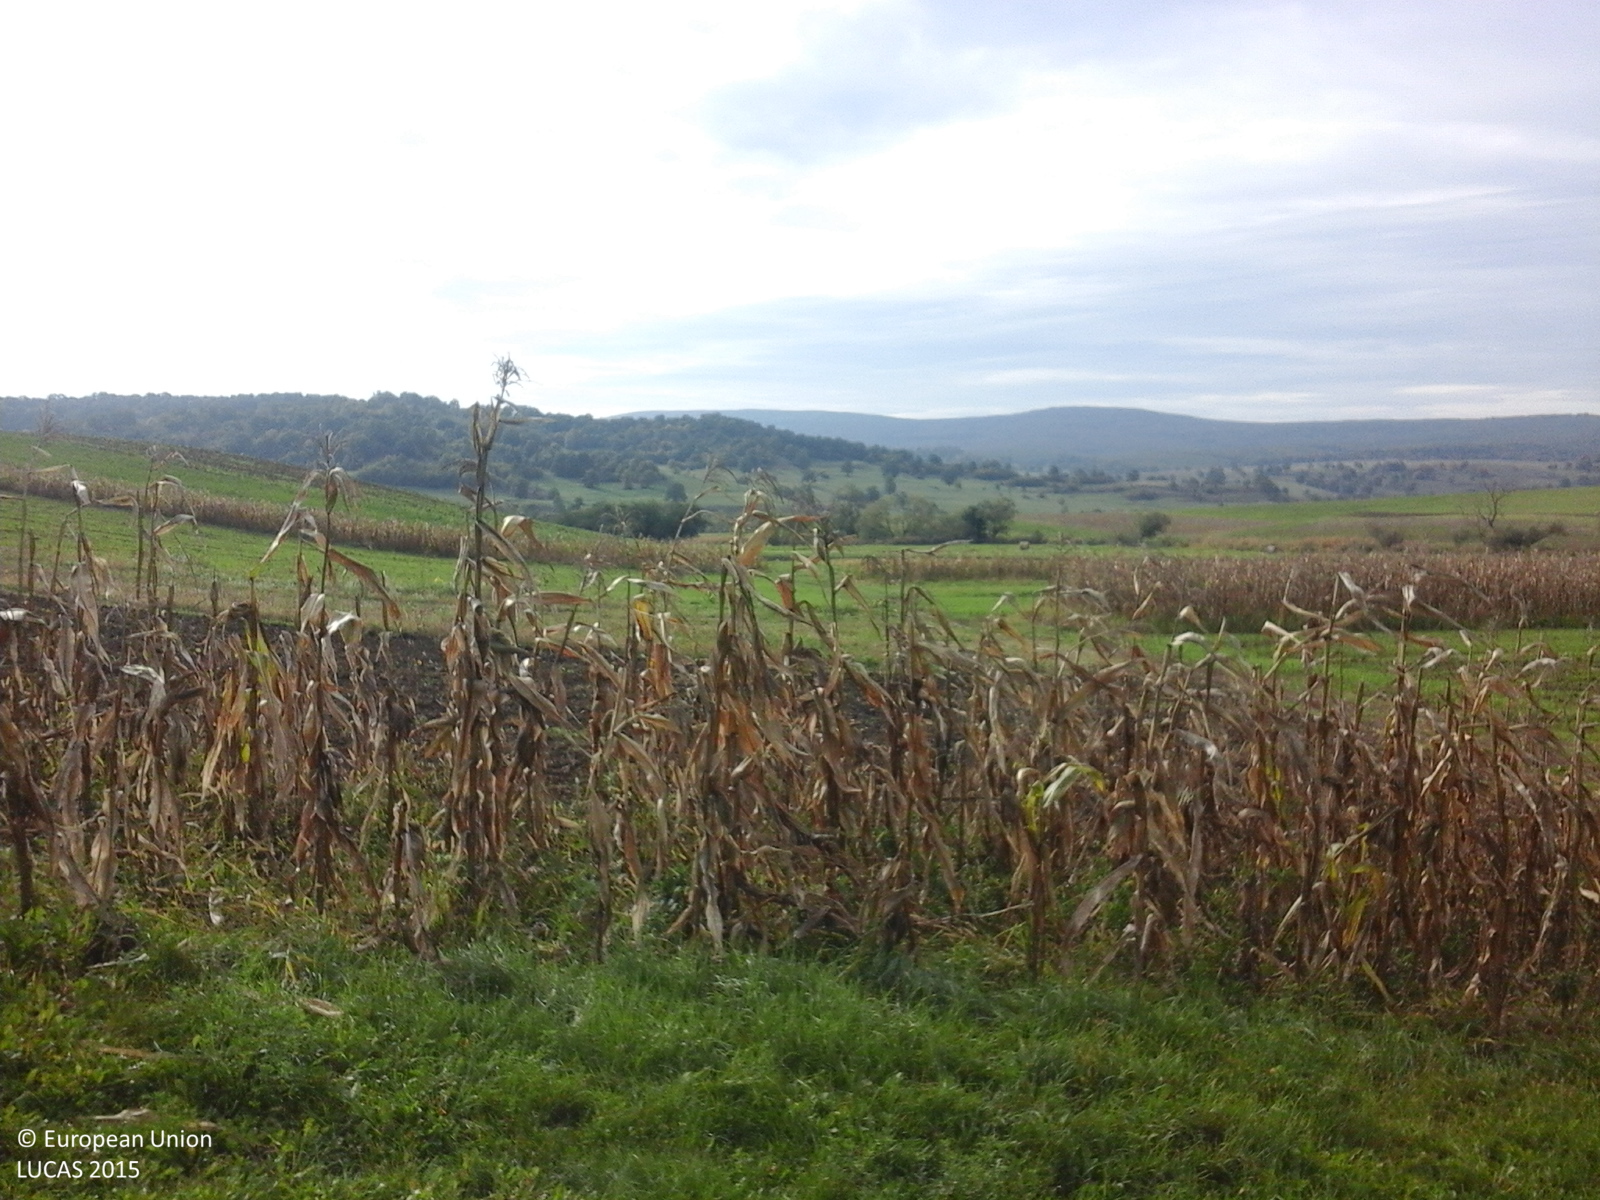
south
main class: Cropland
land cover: Lucerne
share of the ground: > 75 %
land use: Agriculture (excluding fallow land and kitchen gardens)
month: October
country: RO
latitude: 46.1991
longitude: 25.1438
